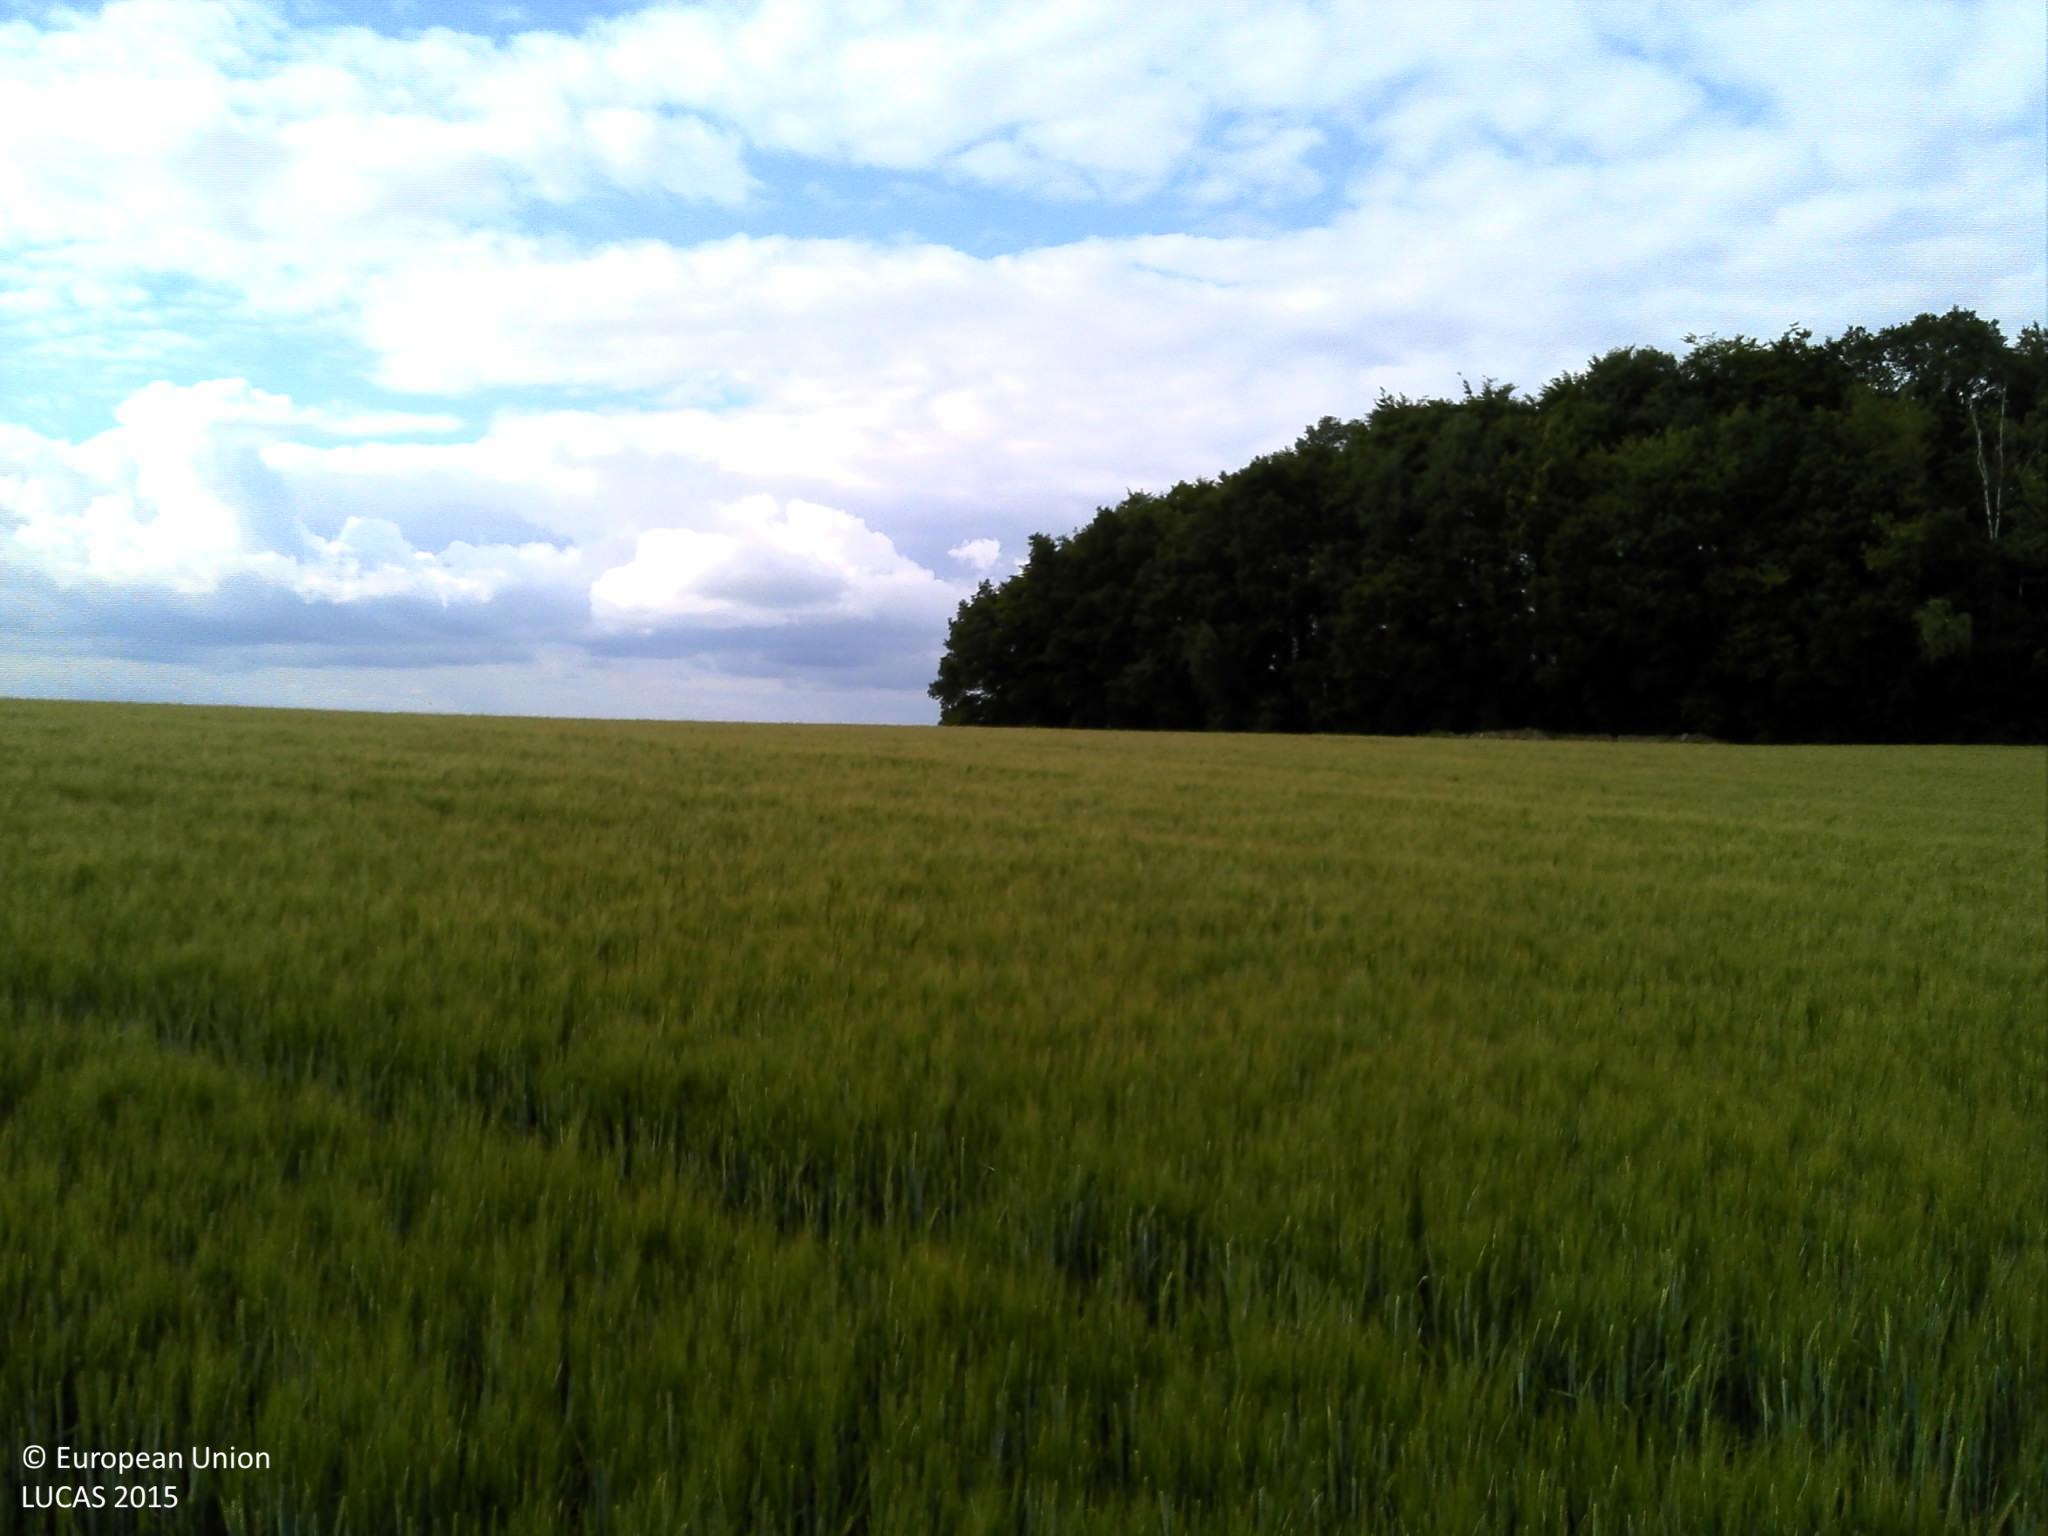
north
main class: Cropland
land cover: Barley
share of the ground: > 75 %
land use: Agriculture (excluding fallow land and kitchen gardens)
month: June
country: FR
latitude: 49.6513
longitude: 4.8029
